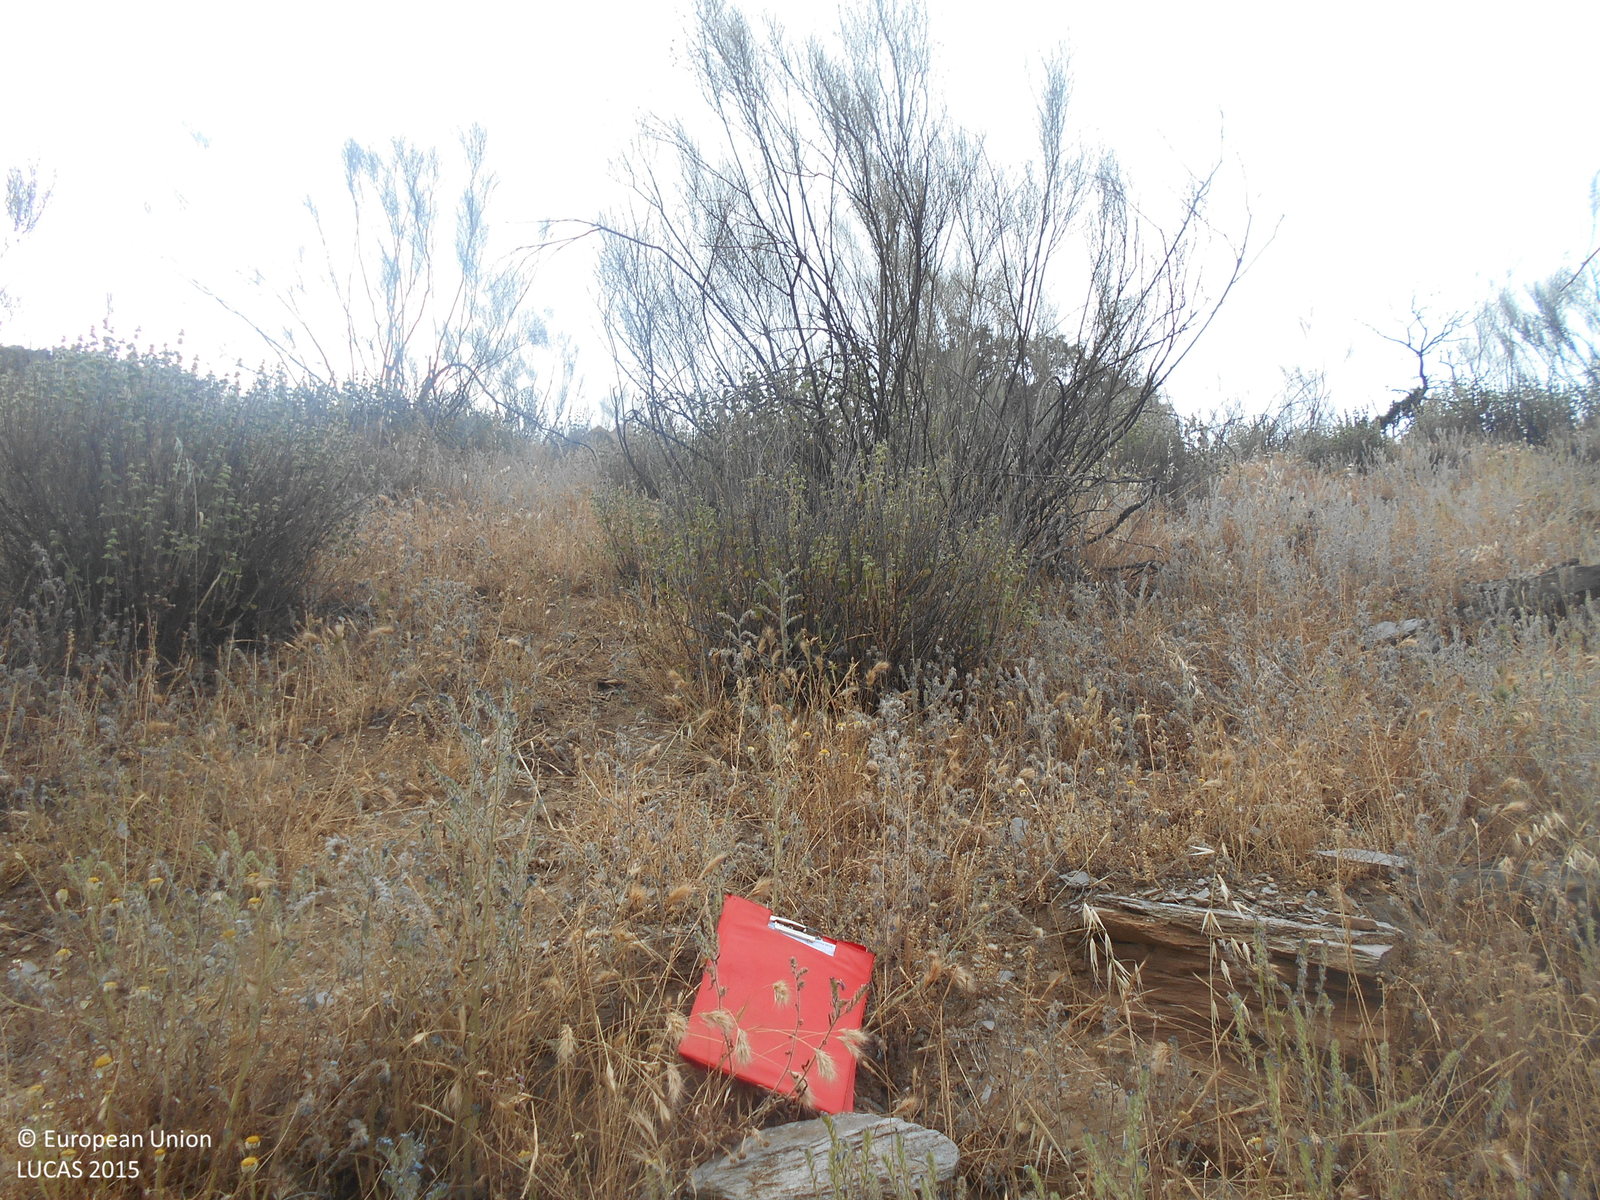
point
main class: Shrubland
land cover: Shrubland without tree cover
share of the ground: 25 - 50 %
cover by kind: shrubs 40 %, herbaceous plants 40 %, consolidated bare surface 10 %, unconsolidated bare surface 10 %
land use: Semi-natural and natural areas not in use
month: May
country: ES
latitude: 37.2325
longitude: -2.2089
